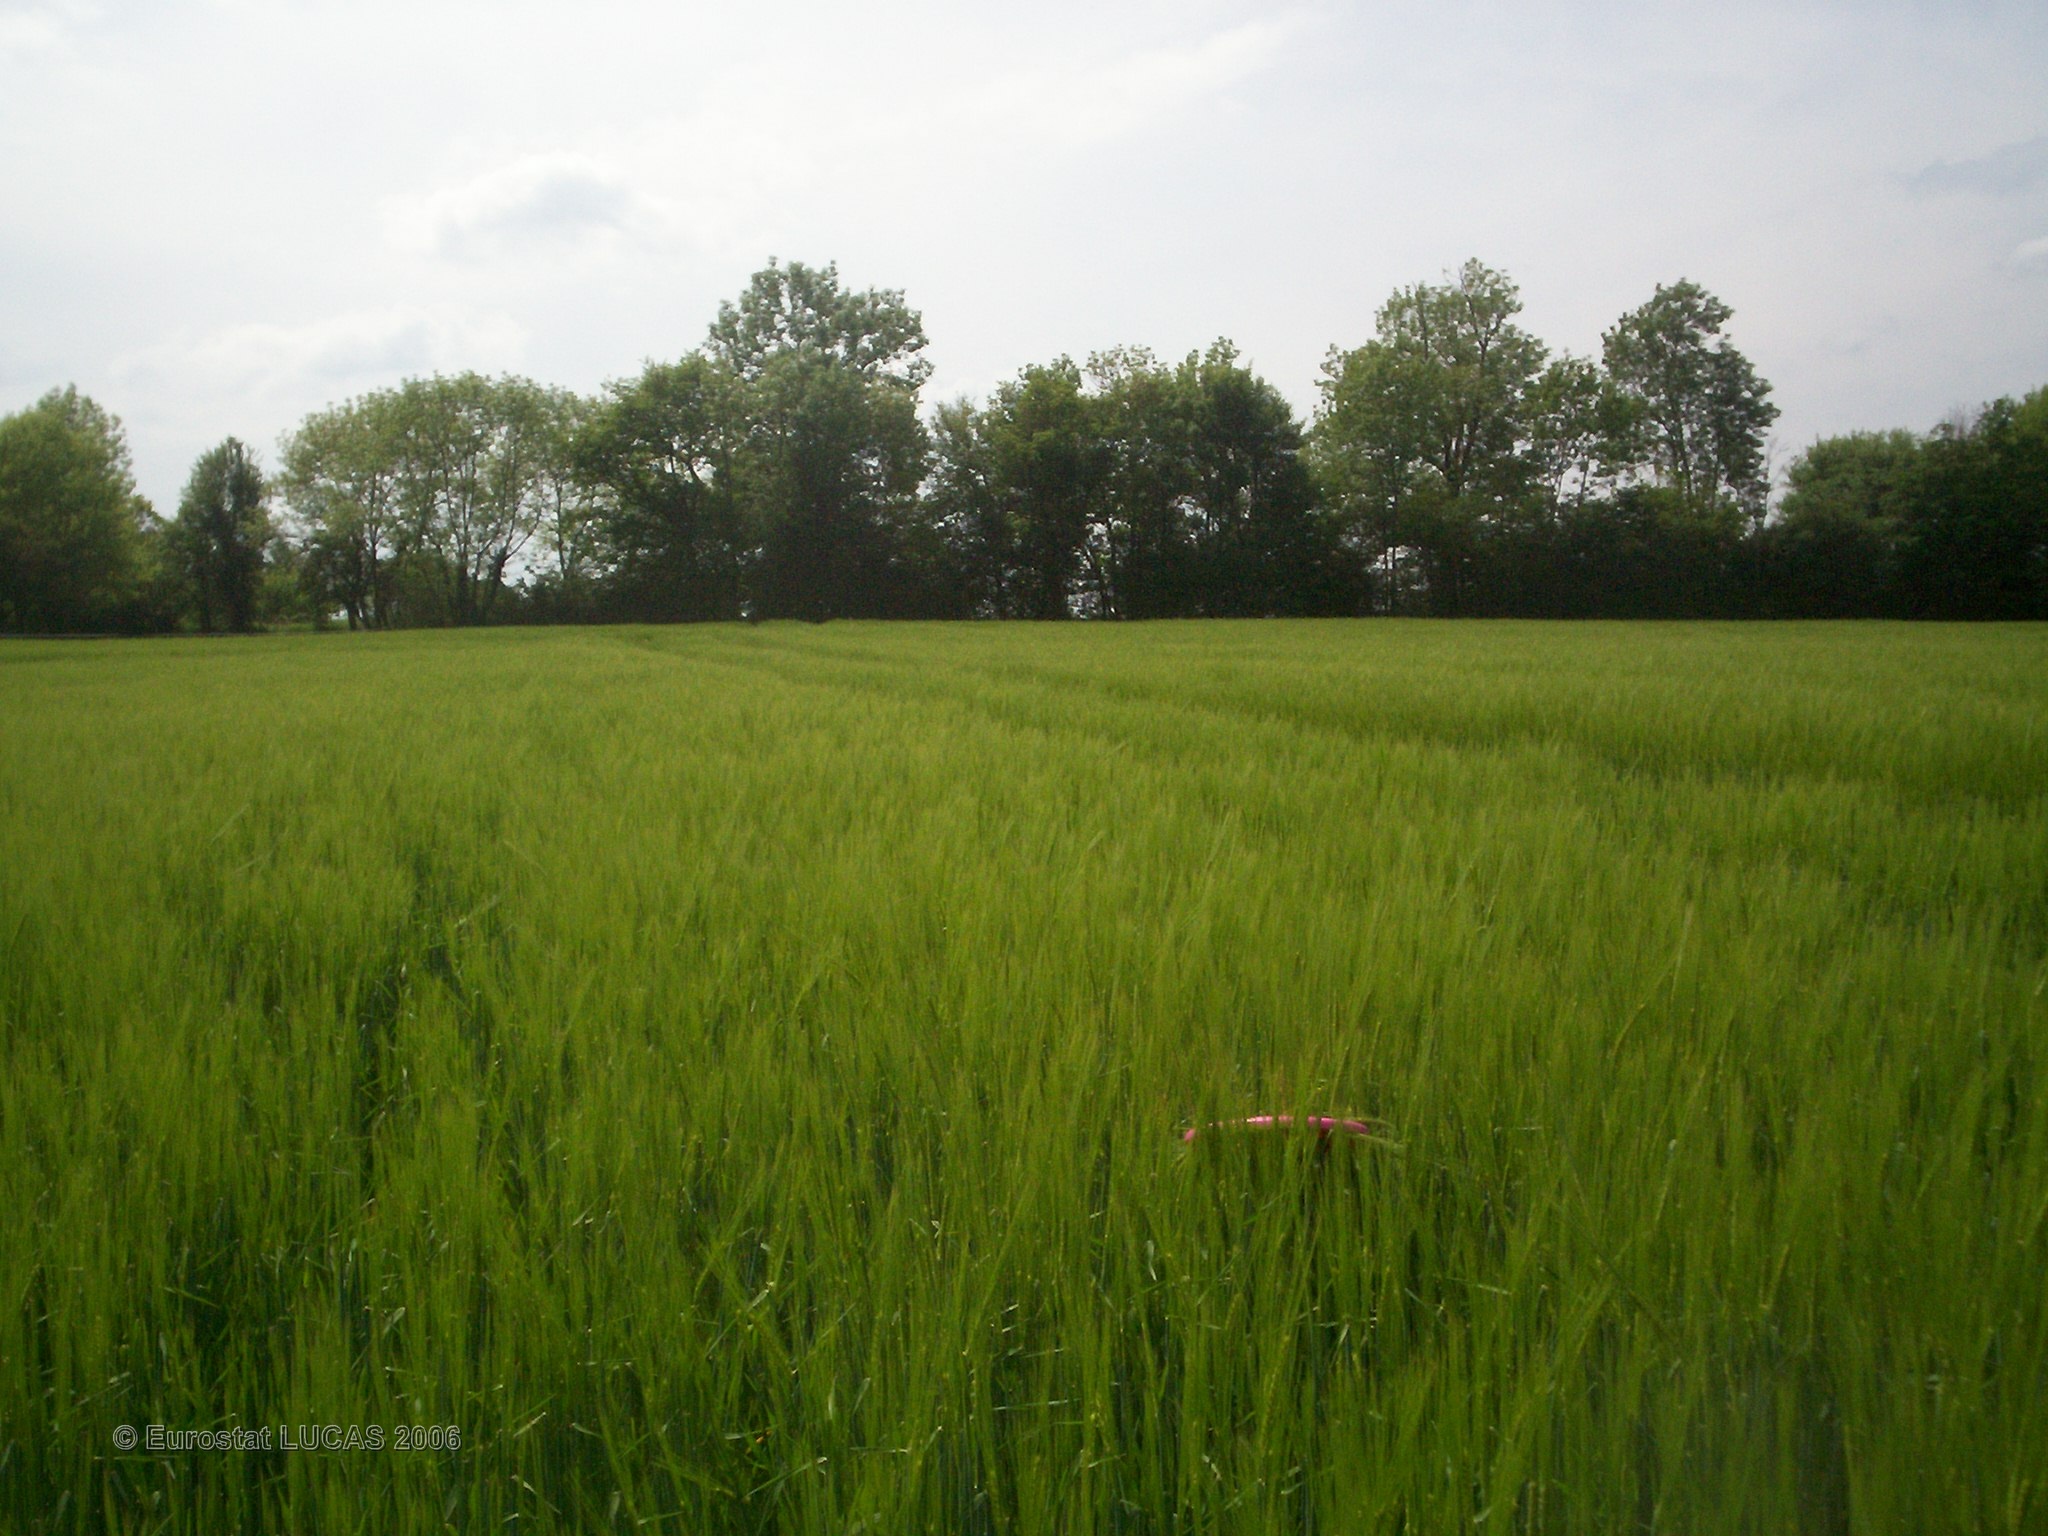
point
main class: Cropland
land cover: Barley
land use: Agriculture (excluding fallow land and kitchen gardens)
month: May
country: FR
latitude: 47.6759
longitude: 3.0010
